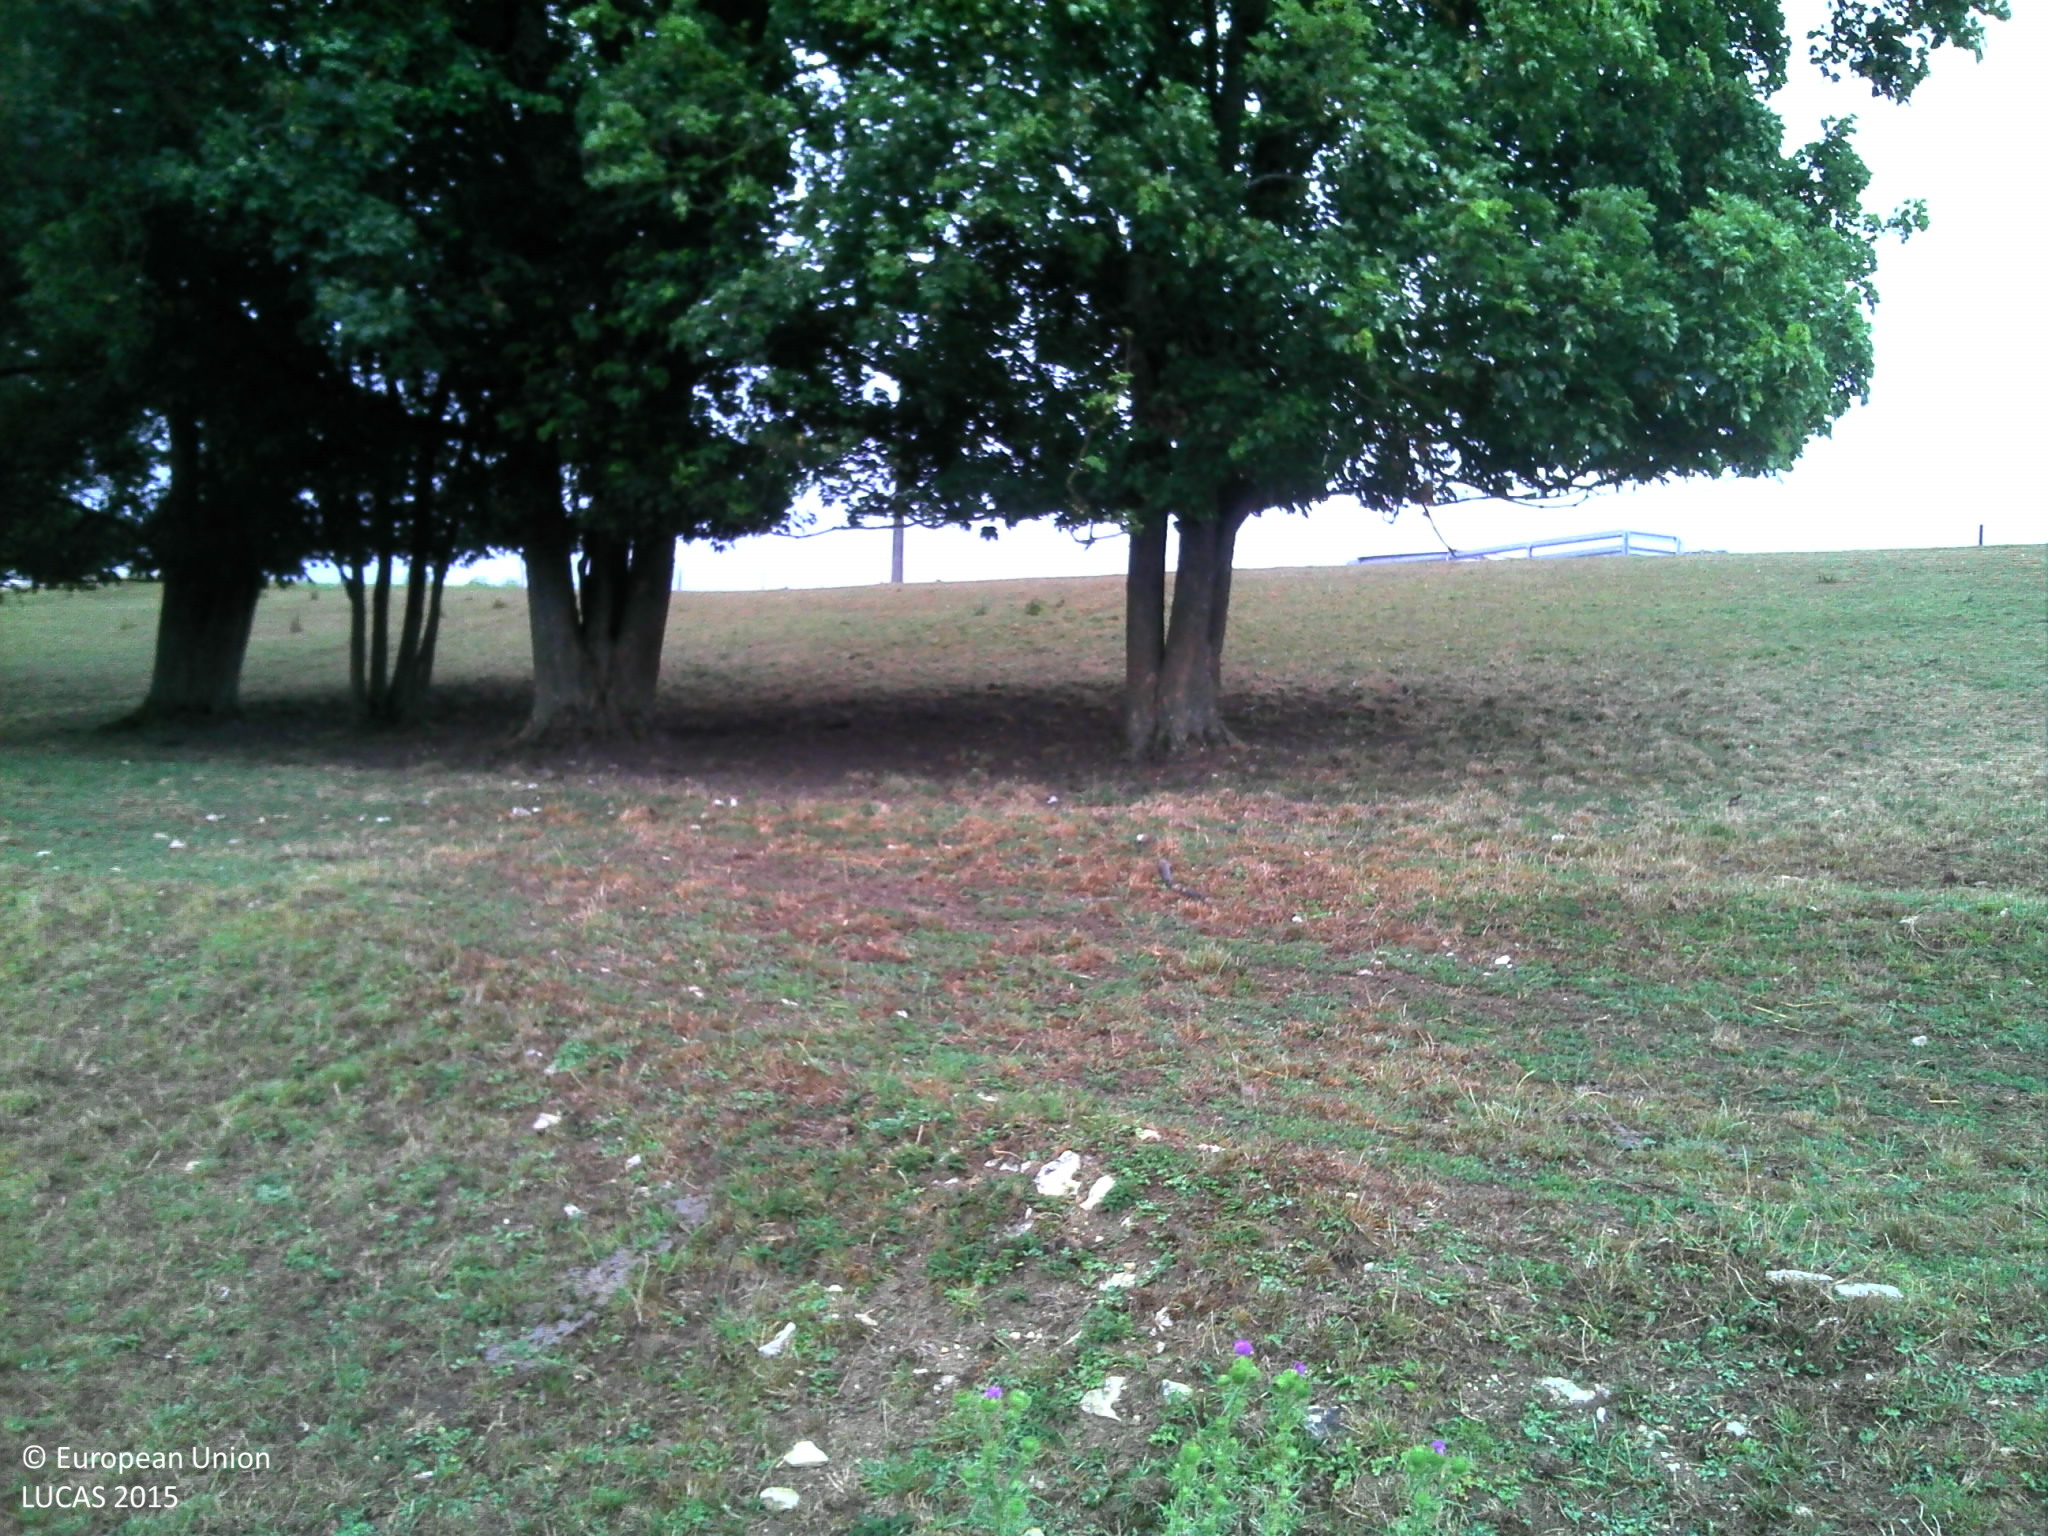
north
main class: Grassland
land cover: Grassland without tree/shrub cover
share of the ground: > 75 %
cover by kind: herbaceous plants 100 %
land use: Agriculture (excluding fallow land and kitchen gardens)
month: July
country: FR
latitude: 49.1757
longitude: 5.0459
